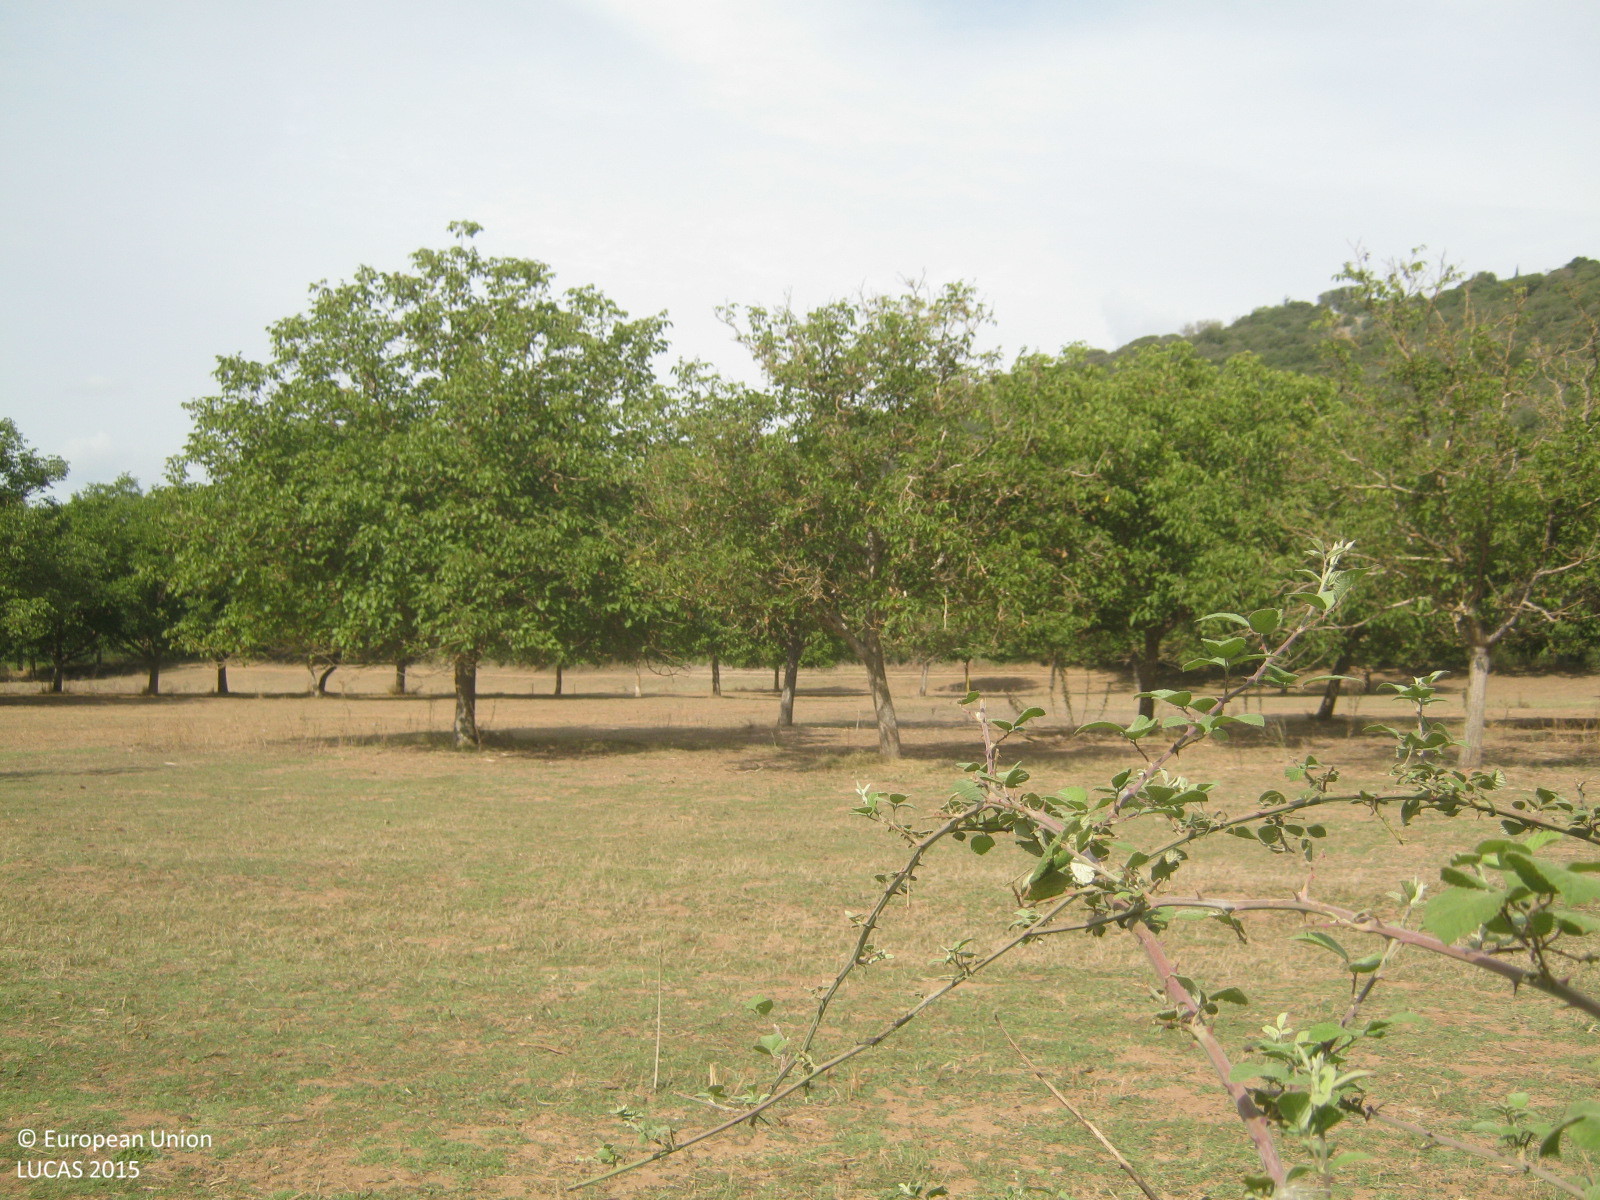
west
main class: Shrubland
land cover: Shrubland with sparse tree cover
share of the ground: > 75 %
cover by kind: shrubs 85 %, herbaceous plants 10 %, broadleaved forest trees 5 %
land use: Agriculture (excluding fallow land and kitchen gardens)
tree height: > 5 m
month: September
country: GR
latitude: 37.8284
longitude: 22.1328
